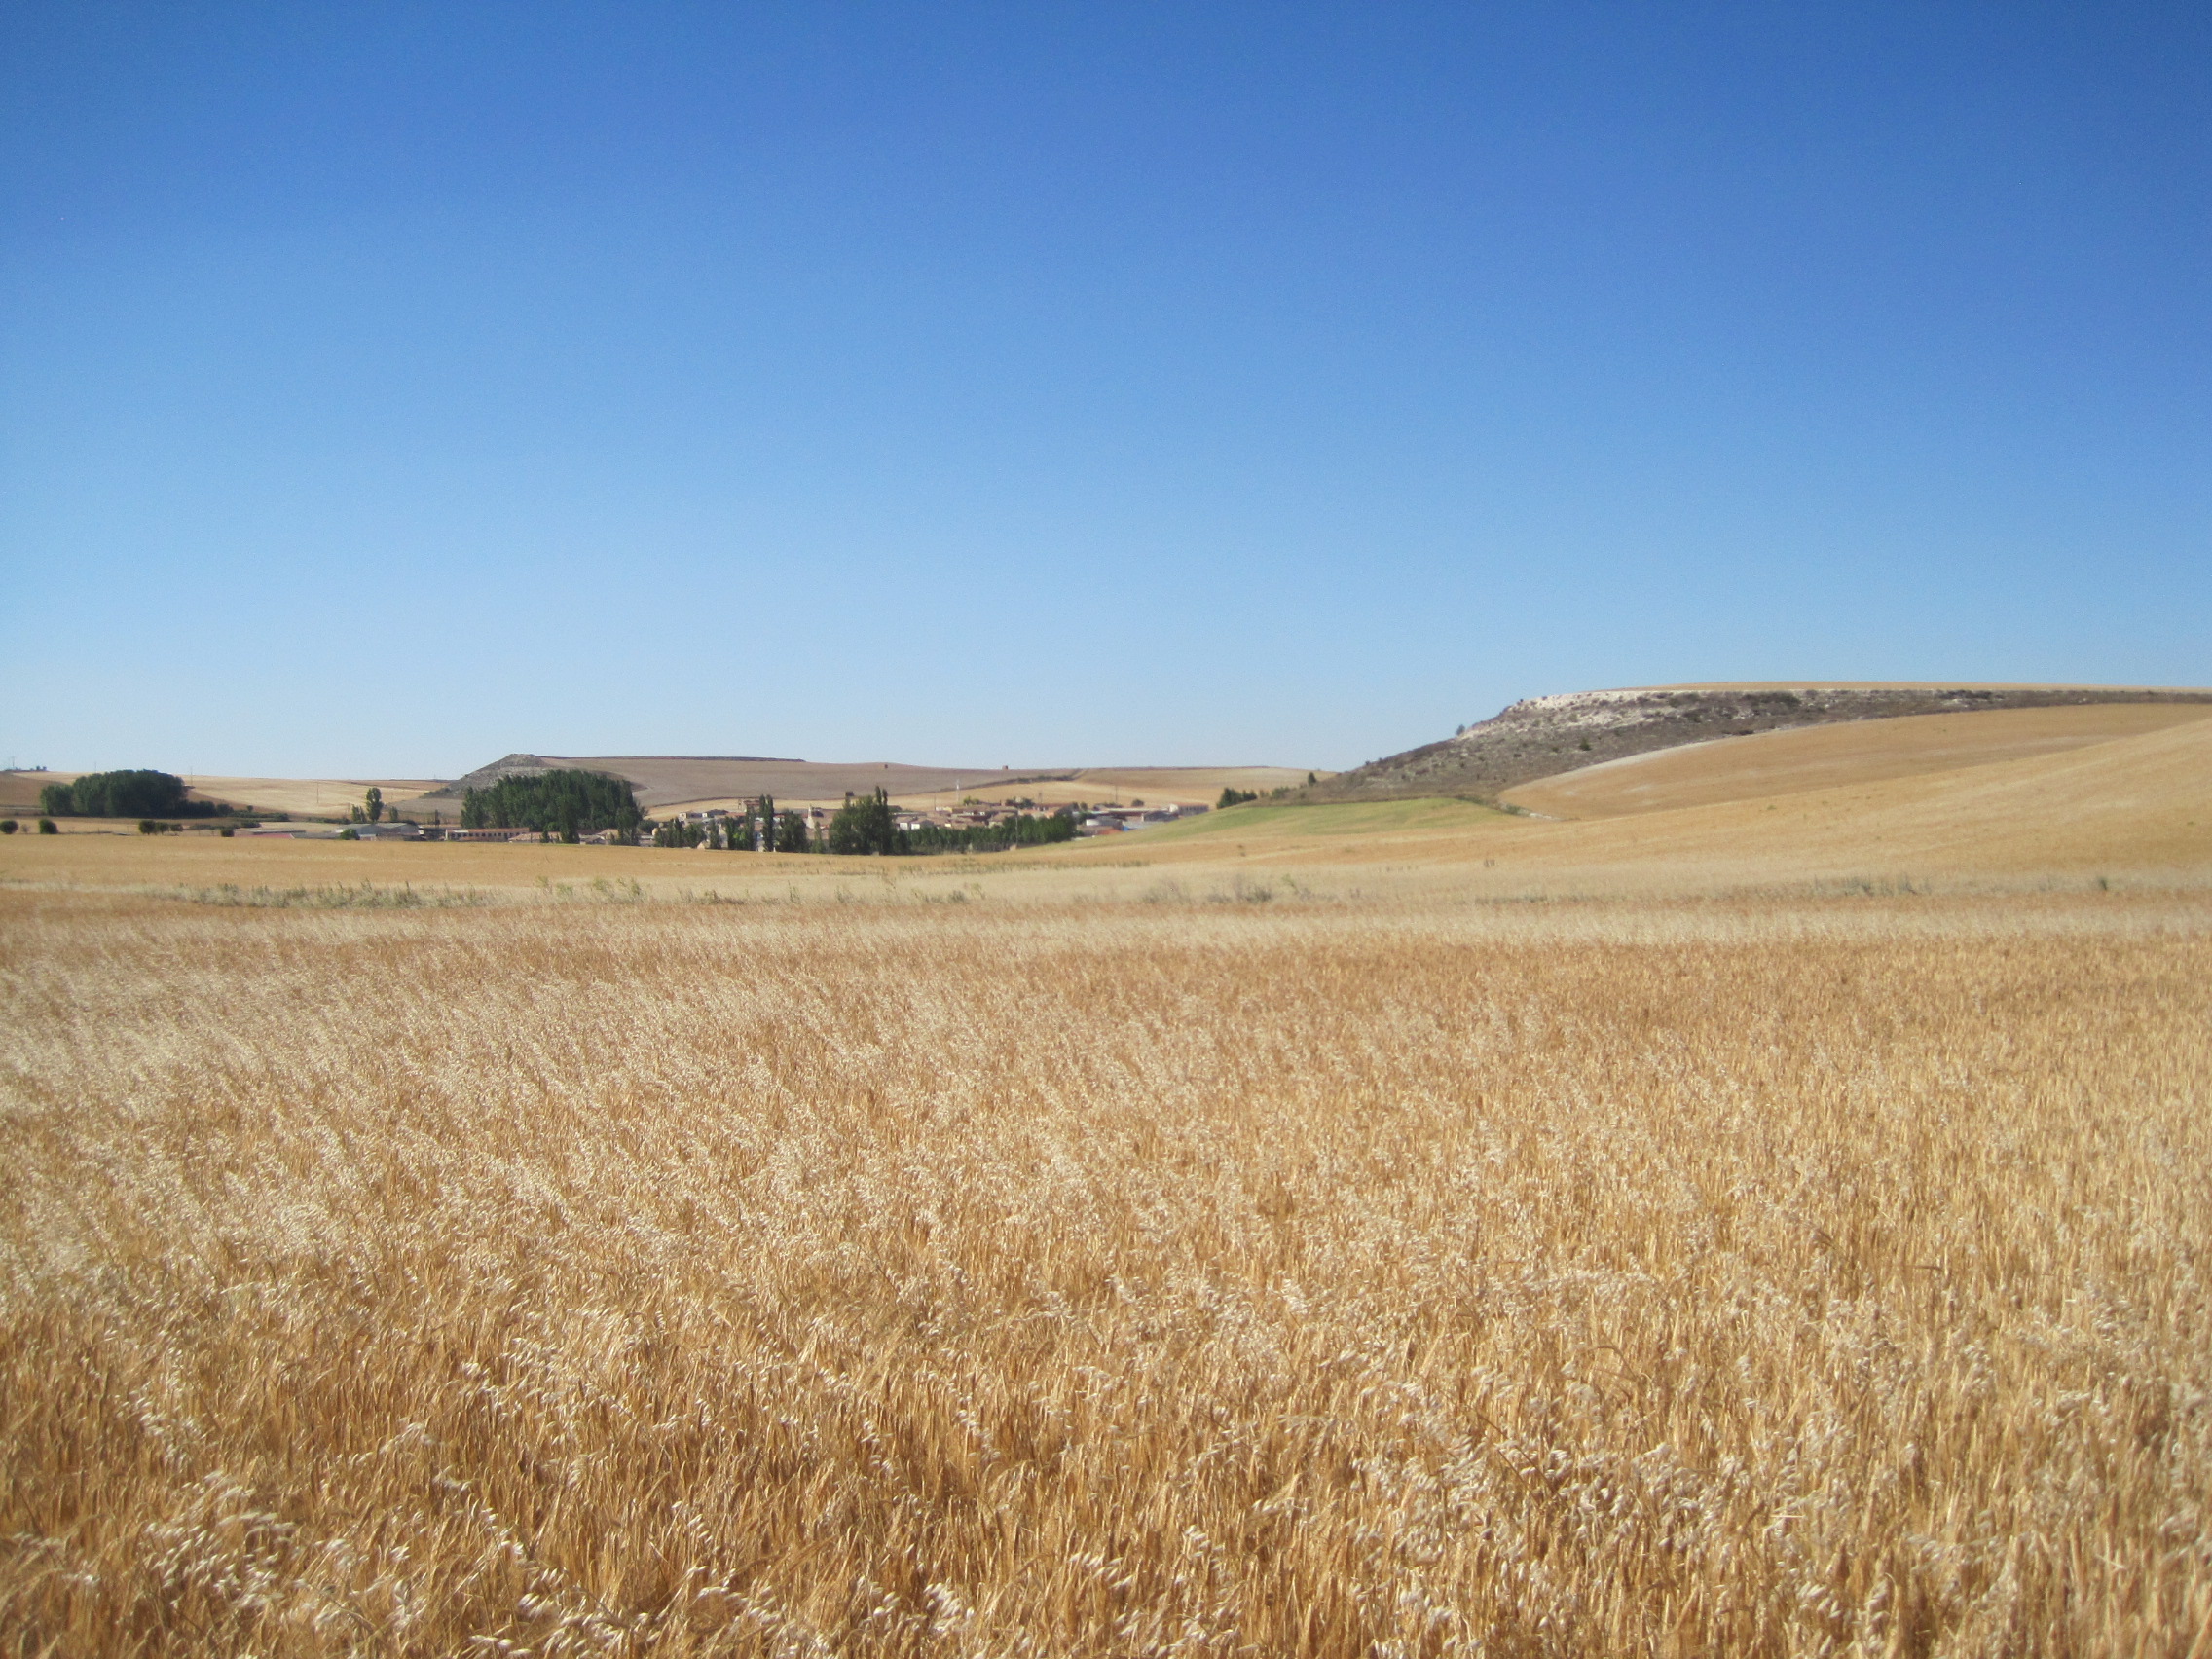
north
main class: Cropland
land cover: Barley
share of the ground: > 75 %
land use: Agriculture (excluding fallow land and kitchen gardens)
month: June
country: ES
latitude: 41.6400
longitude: -5.1188
